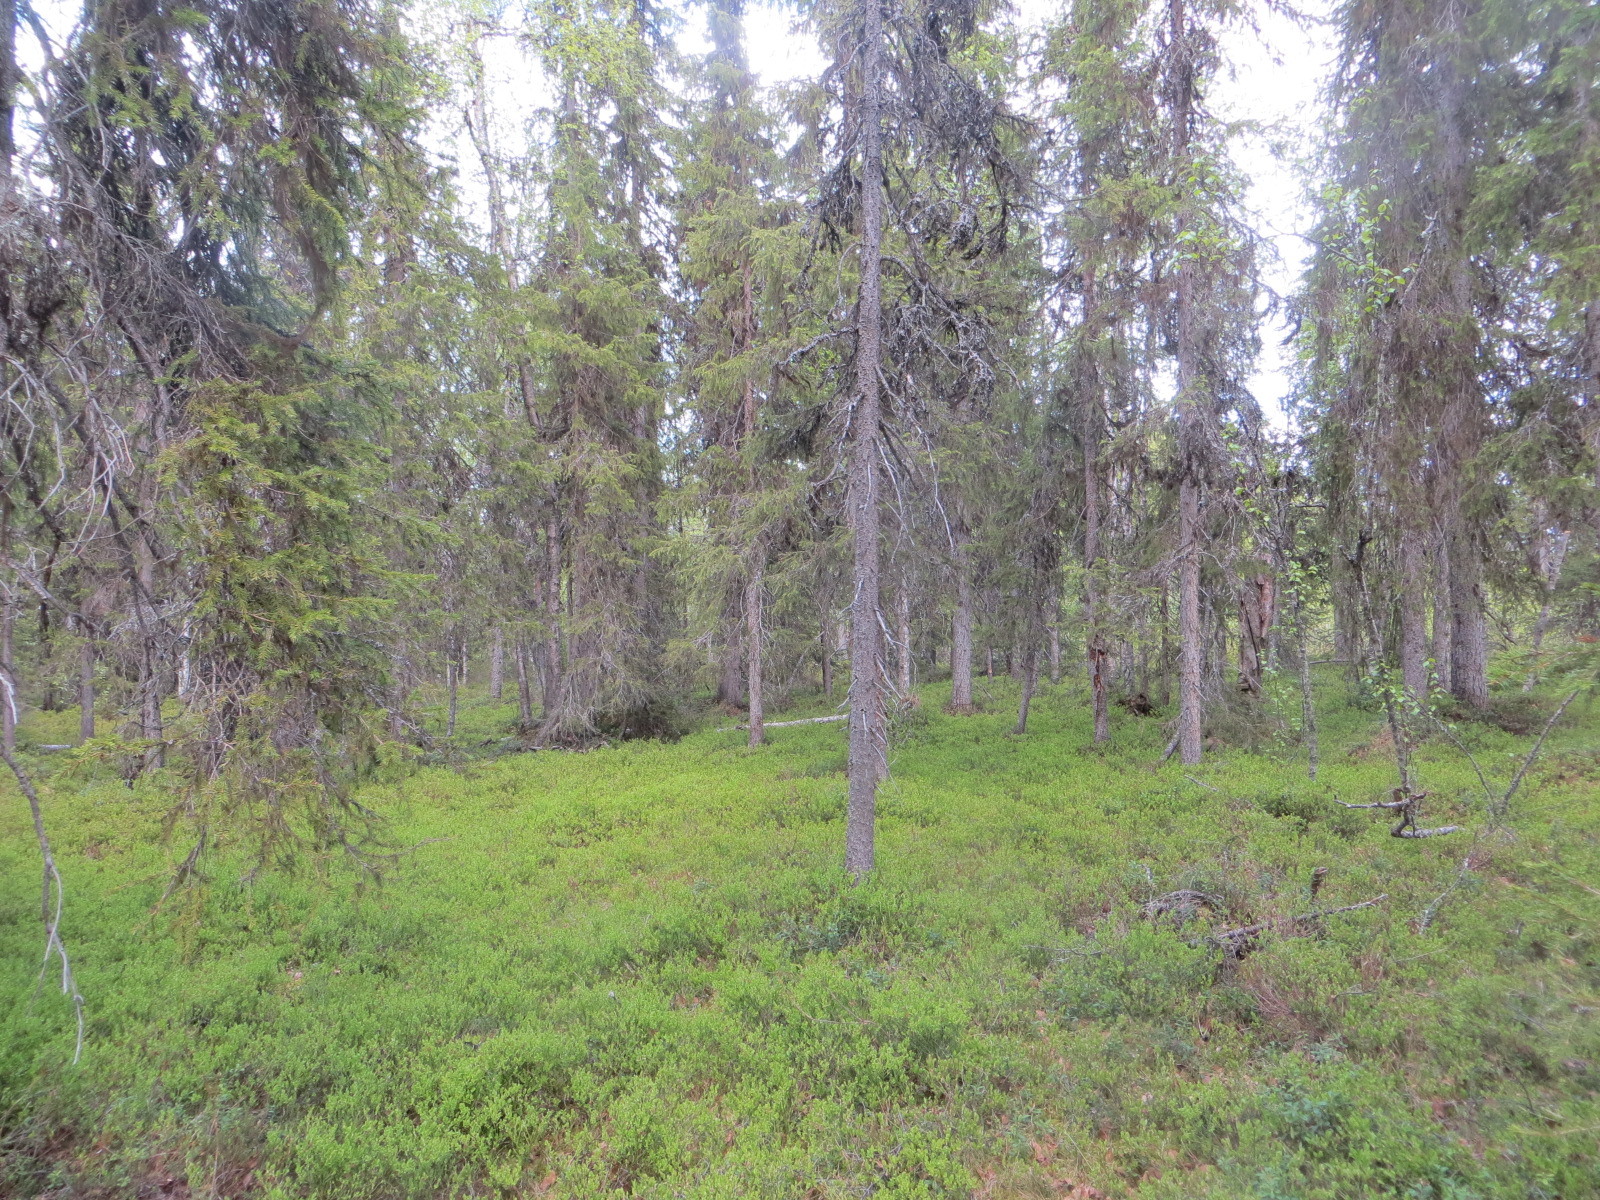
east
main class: Woodland
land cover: Spruce dominated mixed woodland
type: boreal forest
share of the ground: 50 - 75 %
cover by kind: coniferous forest trees 60 %, broadleaved forest trees 20 %, shrubs 20 %
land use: Forestry
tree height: > 5 m
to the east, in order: Spruce dominated mixed woodland; Ditches and canals; Pine dominated mixed woodland; Pine dominated coniferous woodland
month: June
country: FI
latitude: 67.4881
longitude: 25.8548
